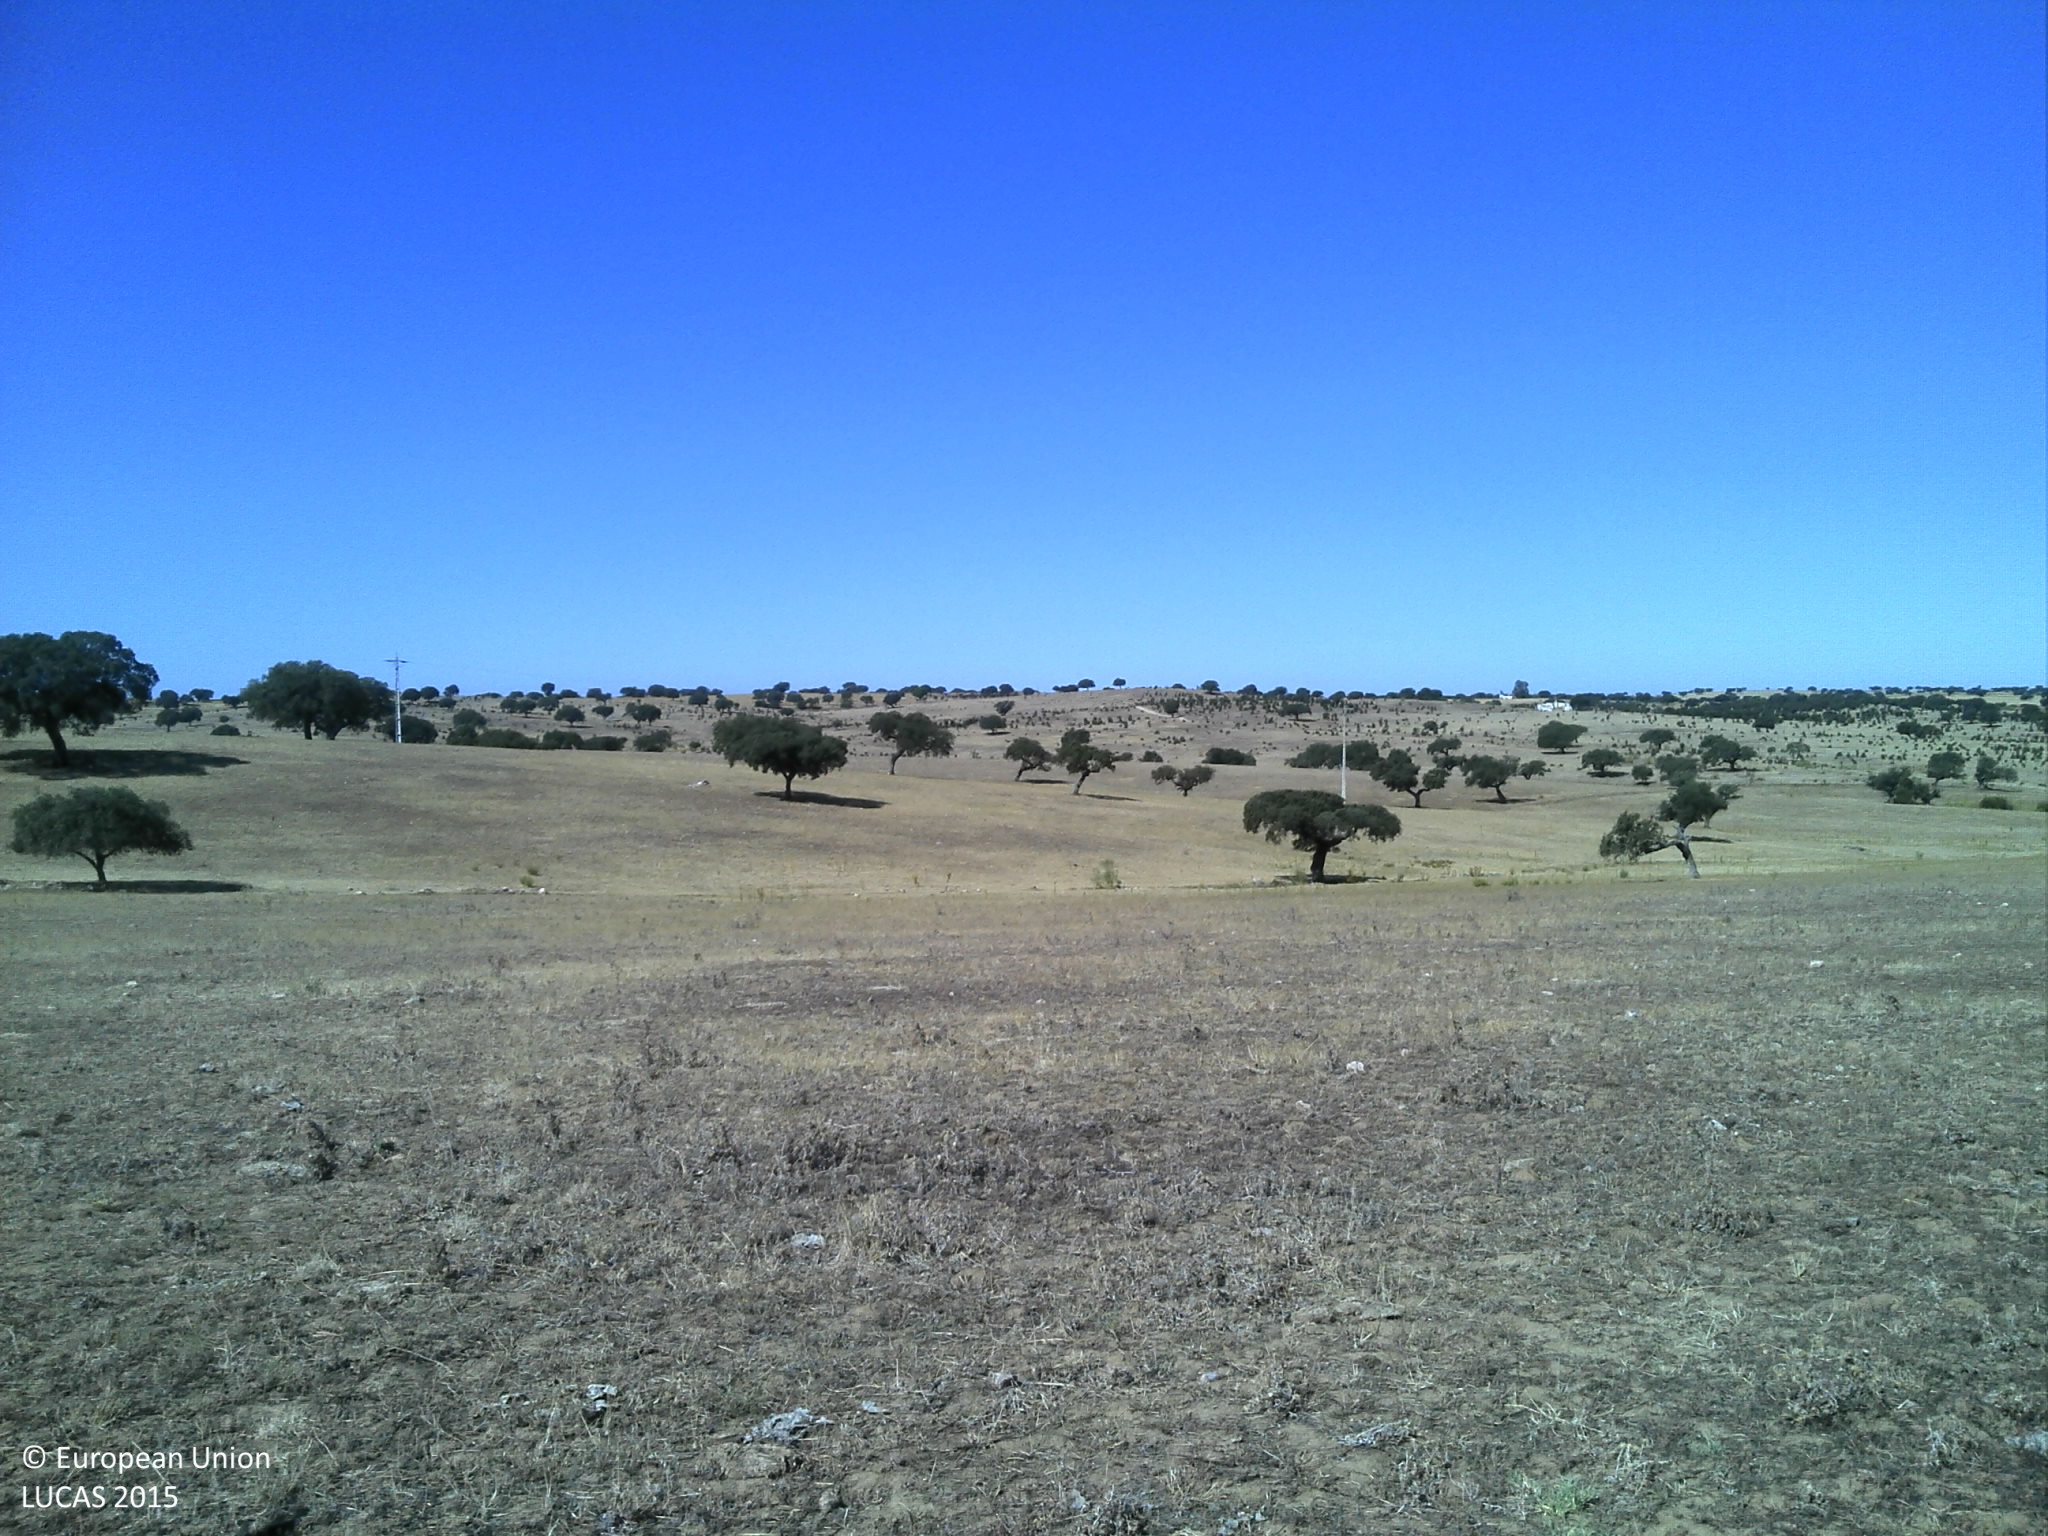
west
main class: Grassland
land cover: Grassland without tree/shrub cover
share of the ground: 10 - 25 %
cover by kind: unconsolidated bare surface 85 %, herbaceous plants 15 %
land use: Agriculture (excluding fallow land and kitchen gardens)
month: July
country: PT
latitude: 39.0765
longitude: -7.1503
